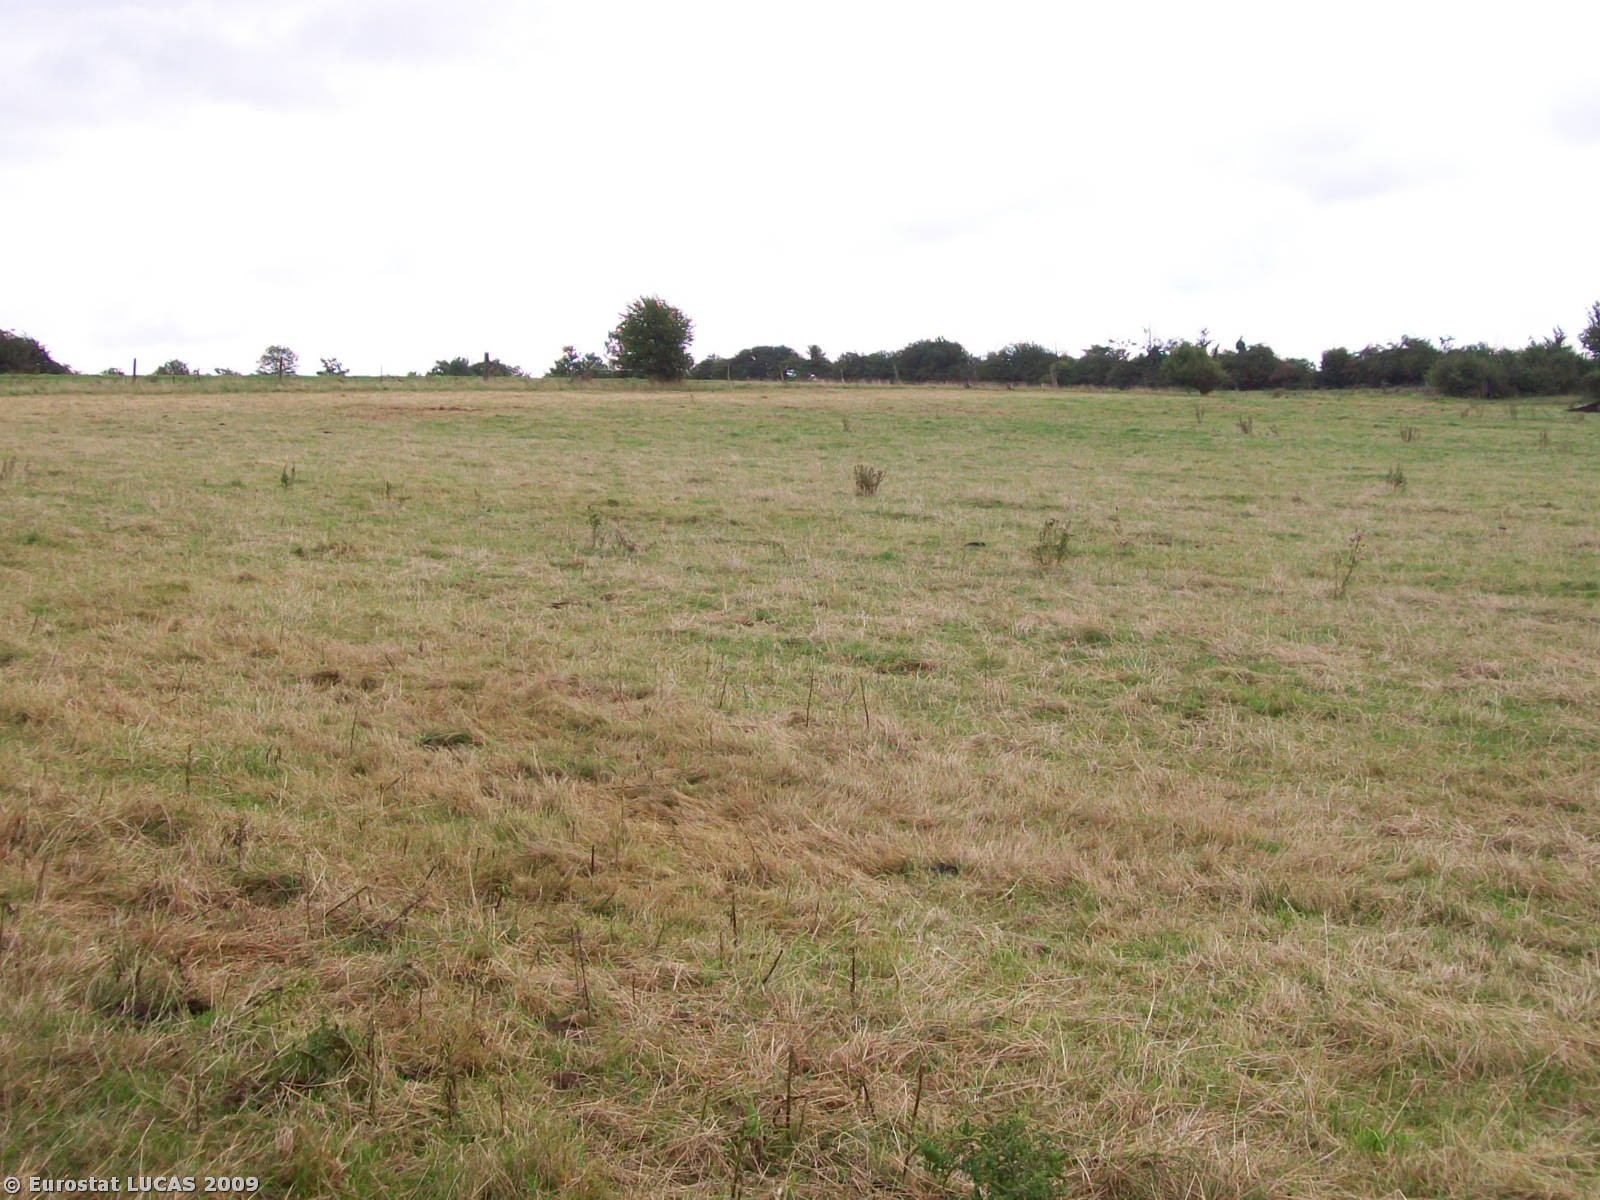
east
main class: Cropland
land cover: Temporary grasslands
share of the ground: > 75 %
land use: Agriculture (excluding fallow land and kitchen gardens)
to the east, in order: Temporary grasslands; Abandoned hedges; Ditches and canals; Fences; Grassland without tree/shrub cover; Fences; Grassland without tree/shrub cover
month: August
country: GB
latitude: 51.7289
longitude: -2.3562
